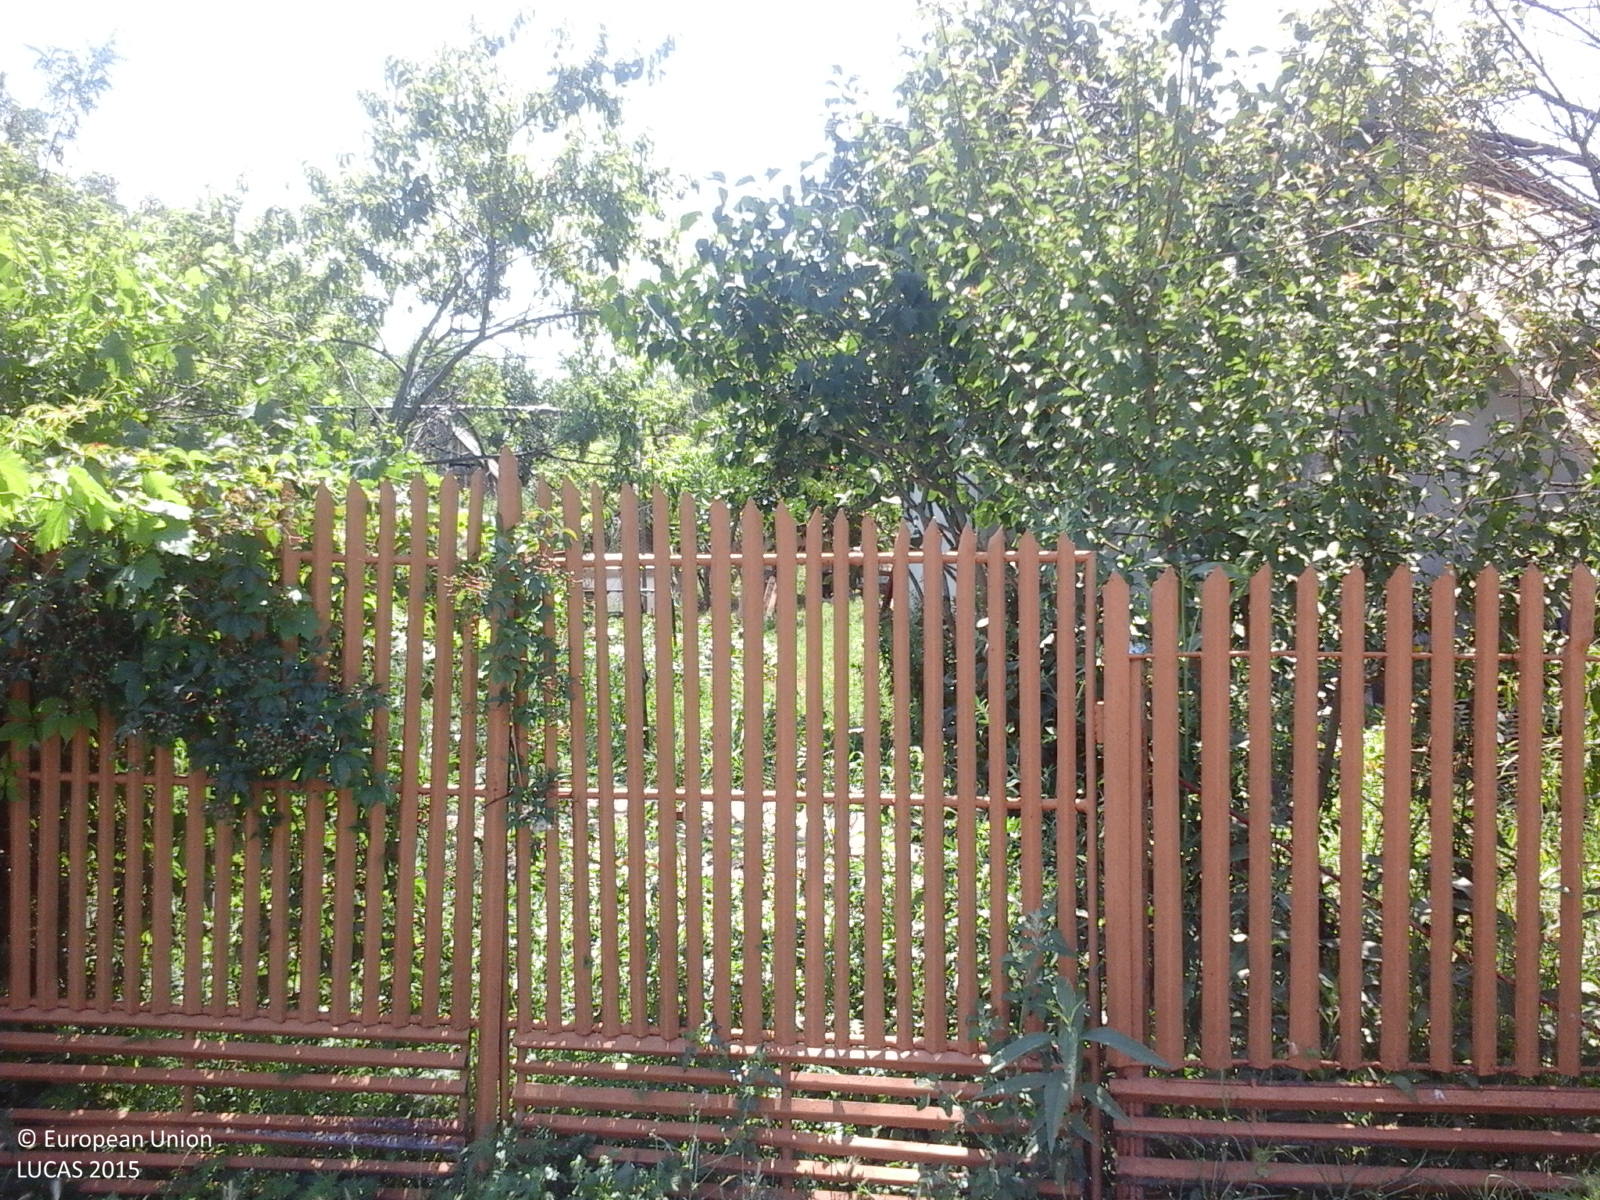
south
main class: Grassland
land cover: Grassland without tree/shrub cover
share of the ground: > 75 %
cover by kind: herbaceous plants 100 %
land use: Residential
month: July
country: RO
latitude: 44.5856
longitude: 27.2540
